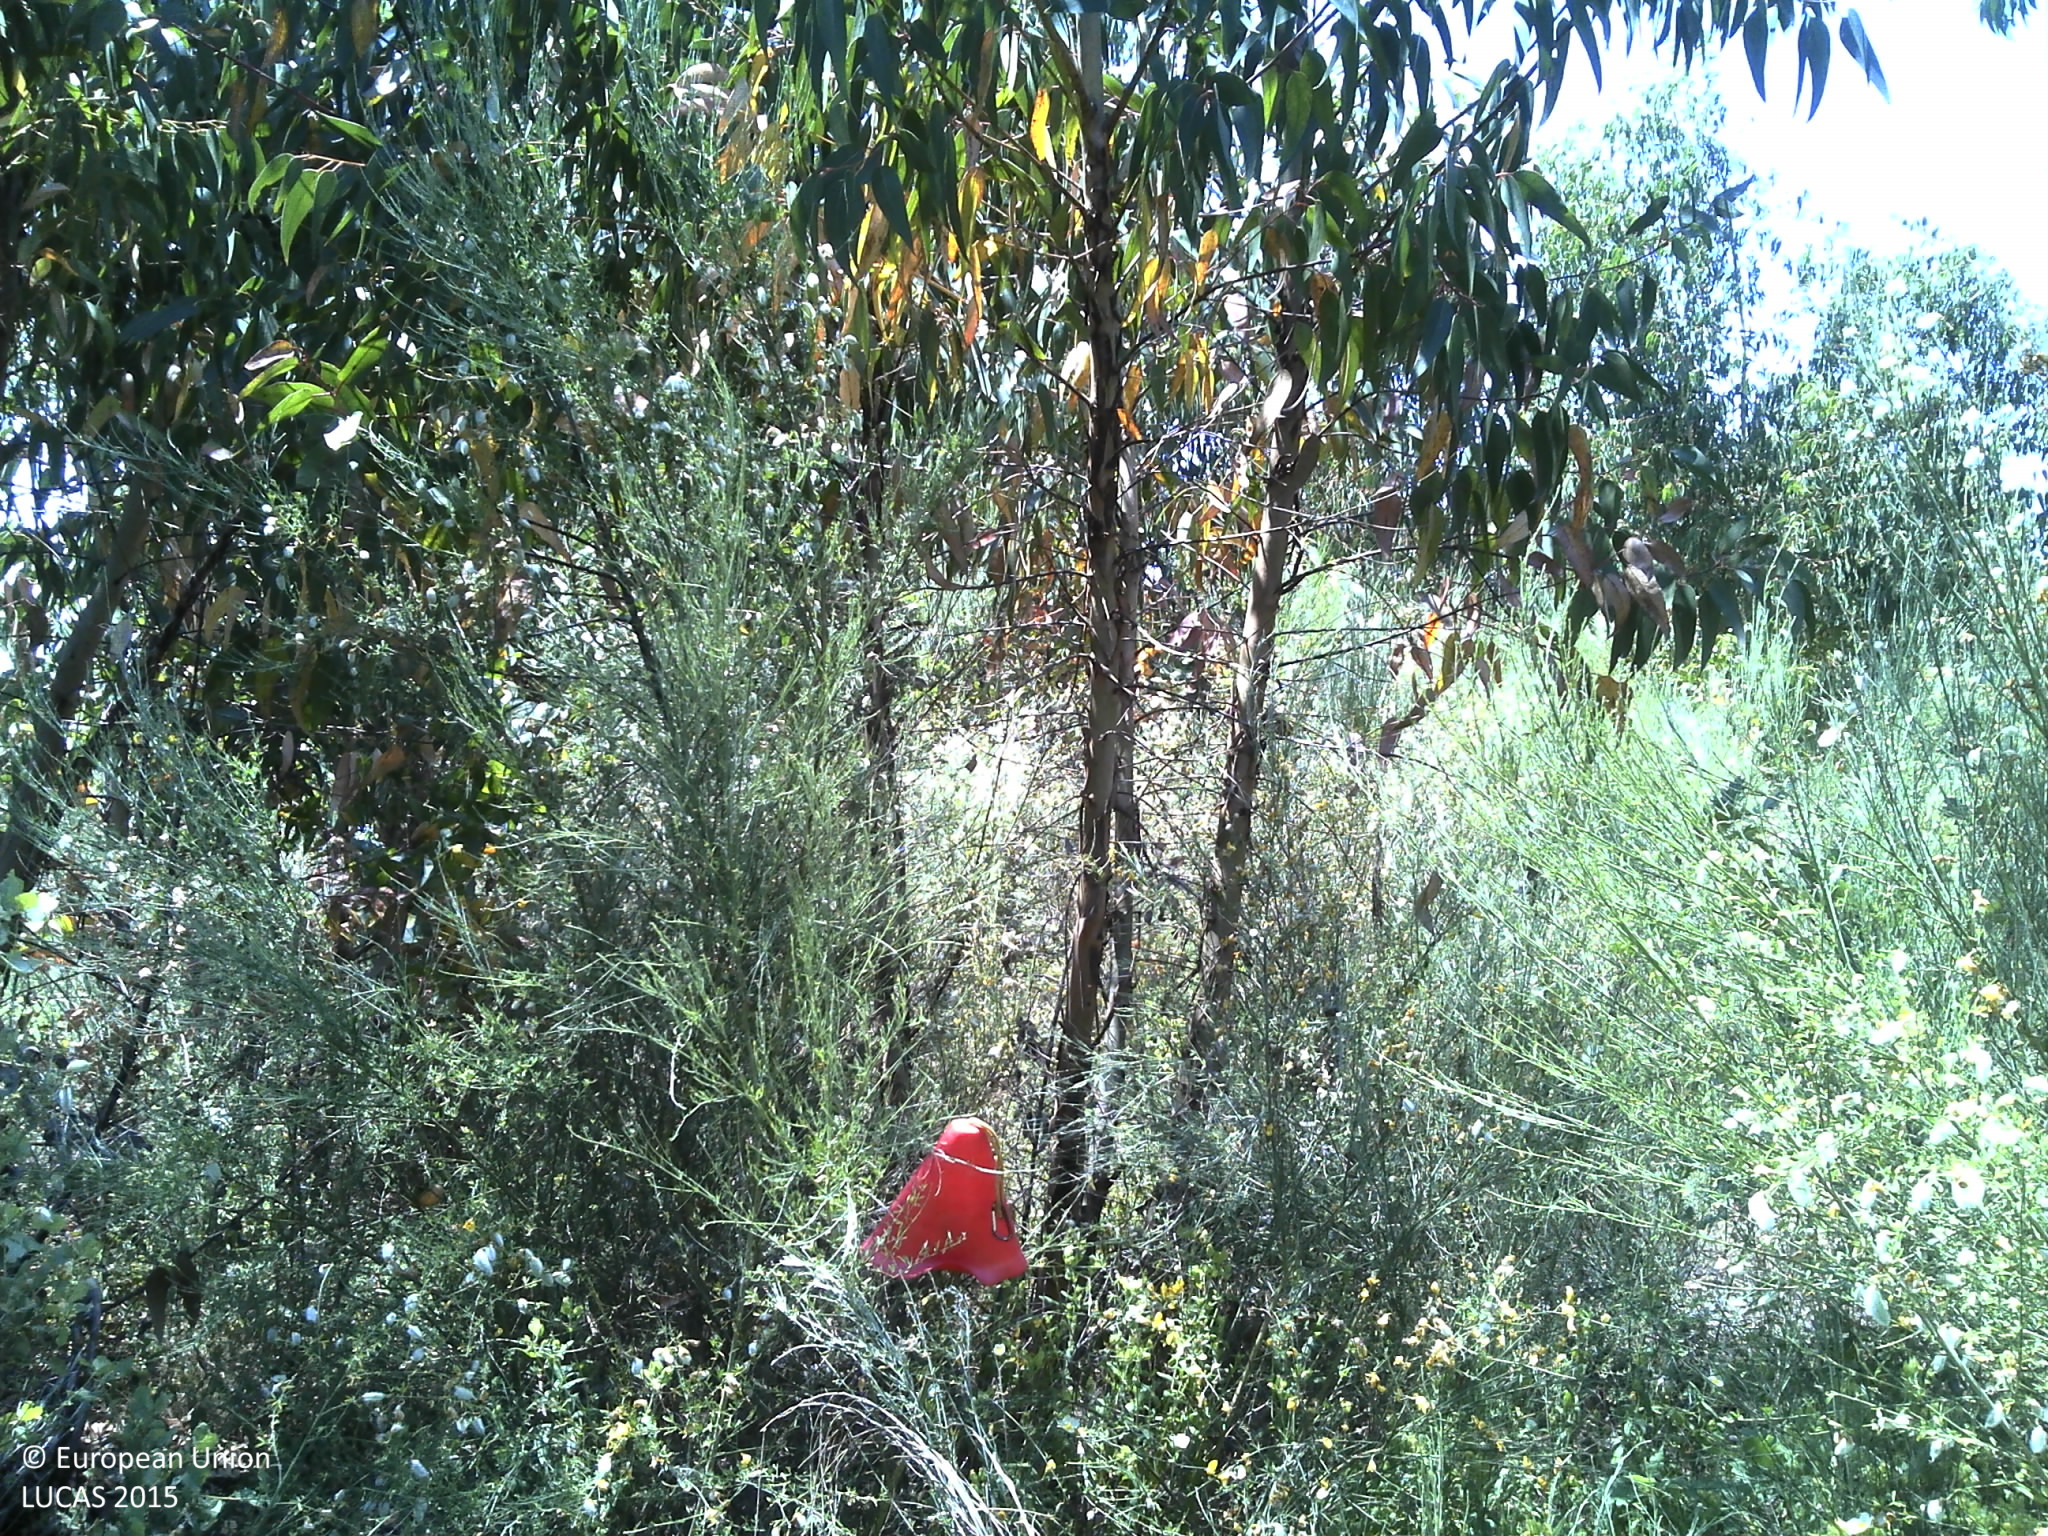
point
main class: Woodland
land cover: Broadleaved woodland
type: exotic forest
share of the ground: 50 - 75 %
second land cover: Shrubland without tree cover
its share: > 75 %
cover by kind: broadleaved forest trees 75 %, shrubs 25 %
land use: Forestry
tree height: > 5 m
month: May
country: PT
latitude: 39.4688
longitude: -7.7316
